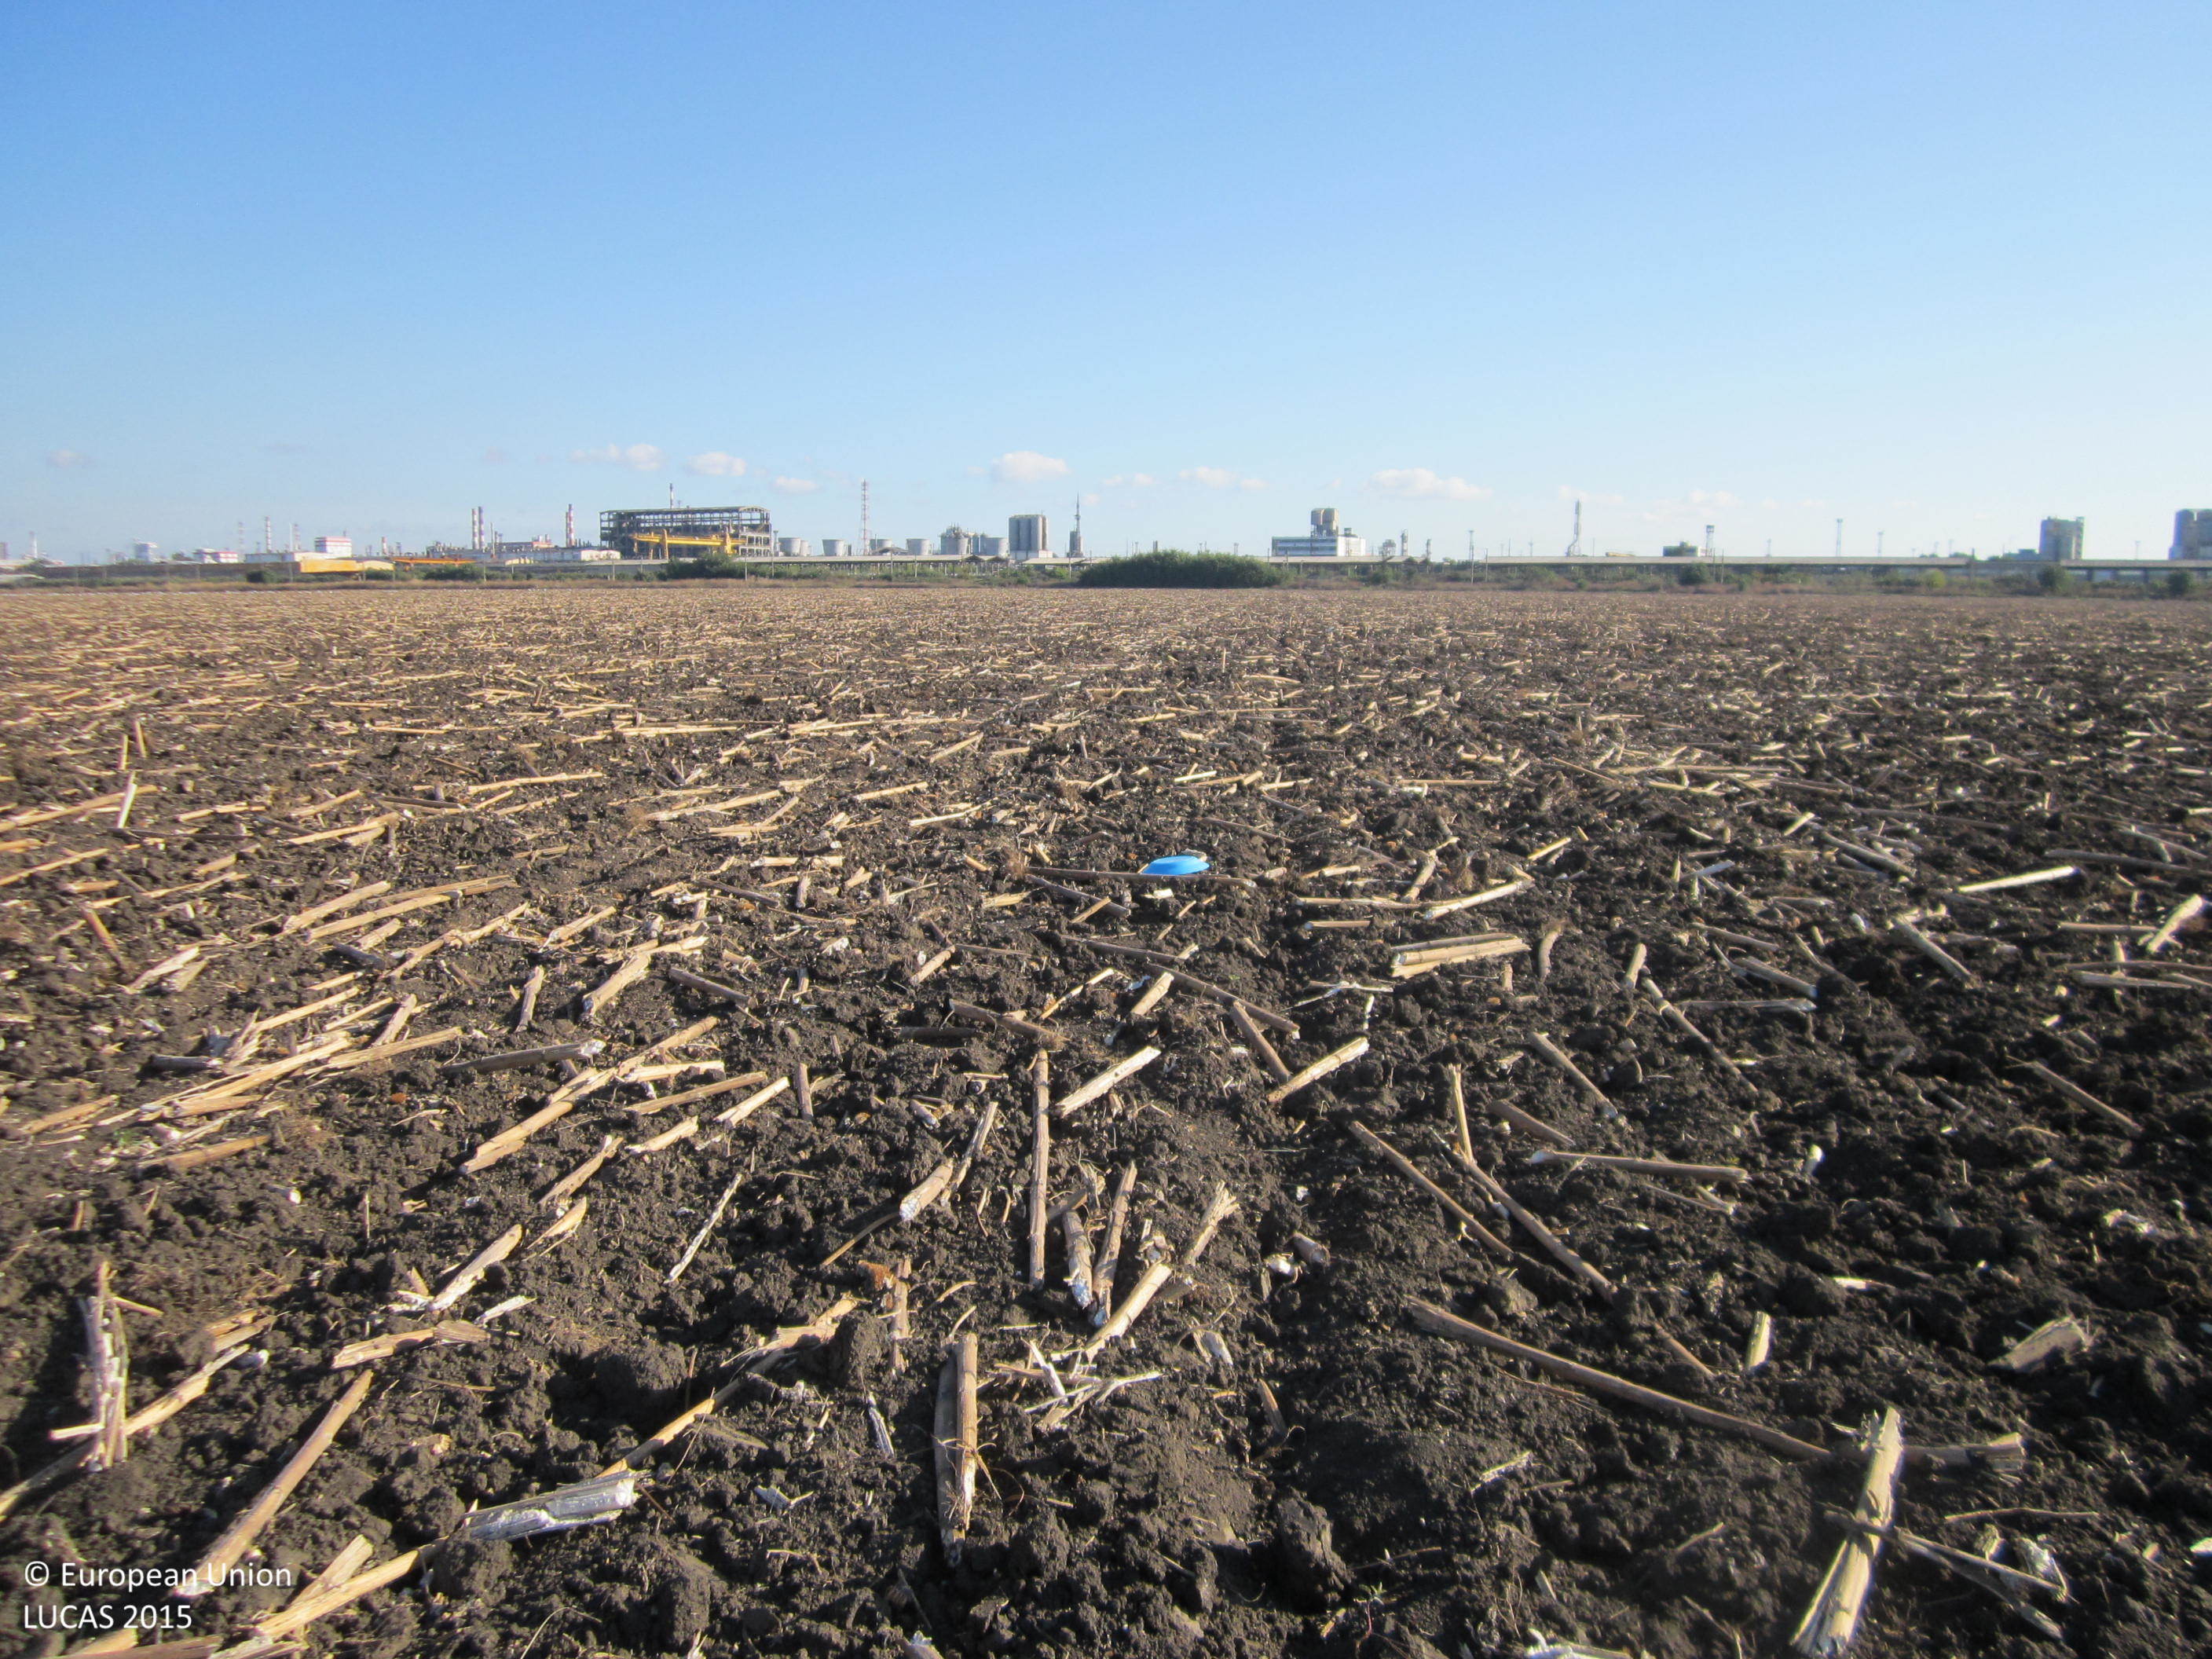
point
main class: Cropland
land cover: Sunflower
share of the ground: < 10 %
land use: Agriculture (excluding fallow land and kitchen gardens)
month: September
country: BG
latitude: 42.5270
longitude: 27.3397
